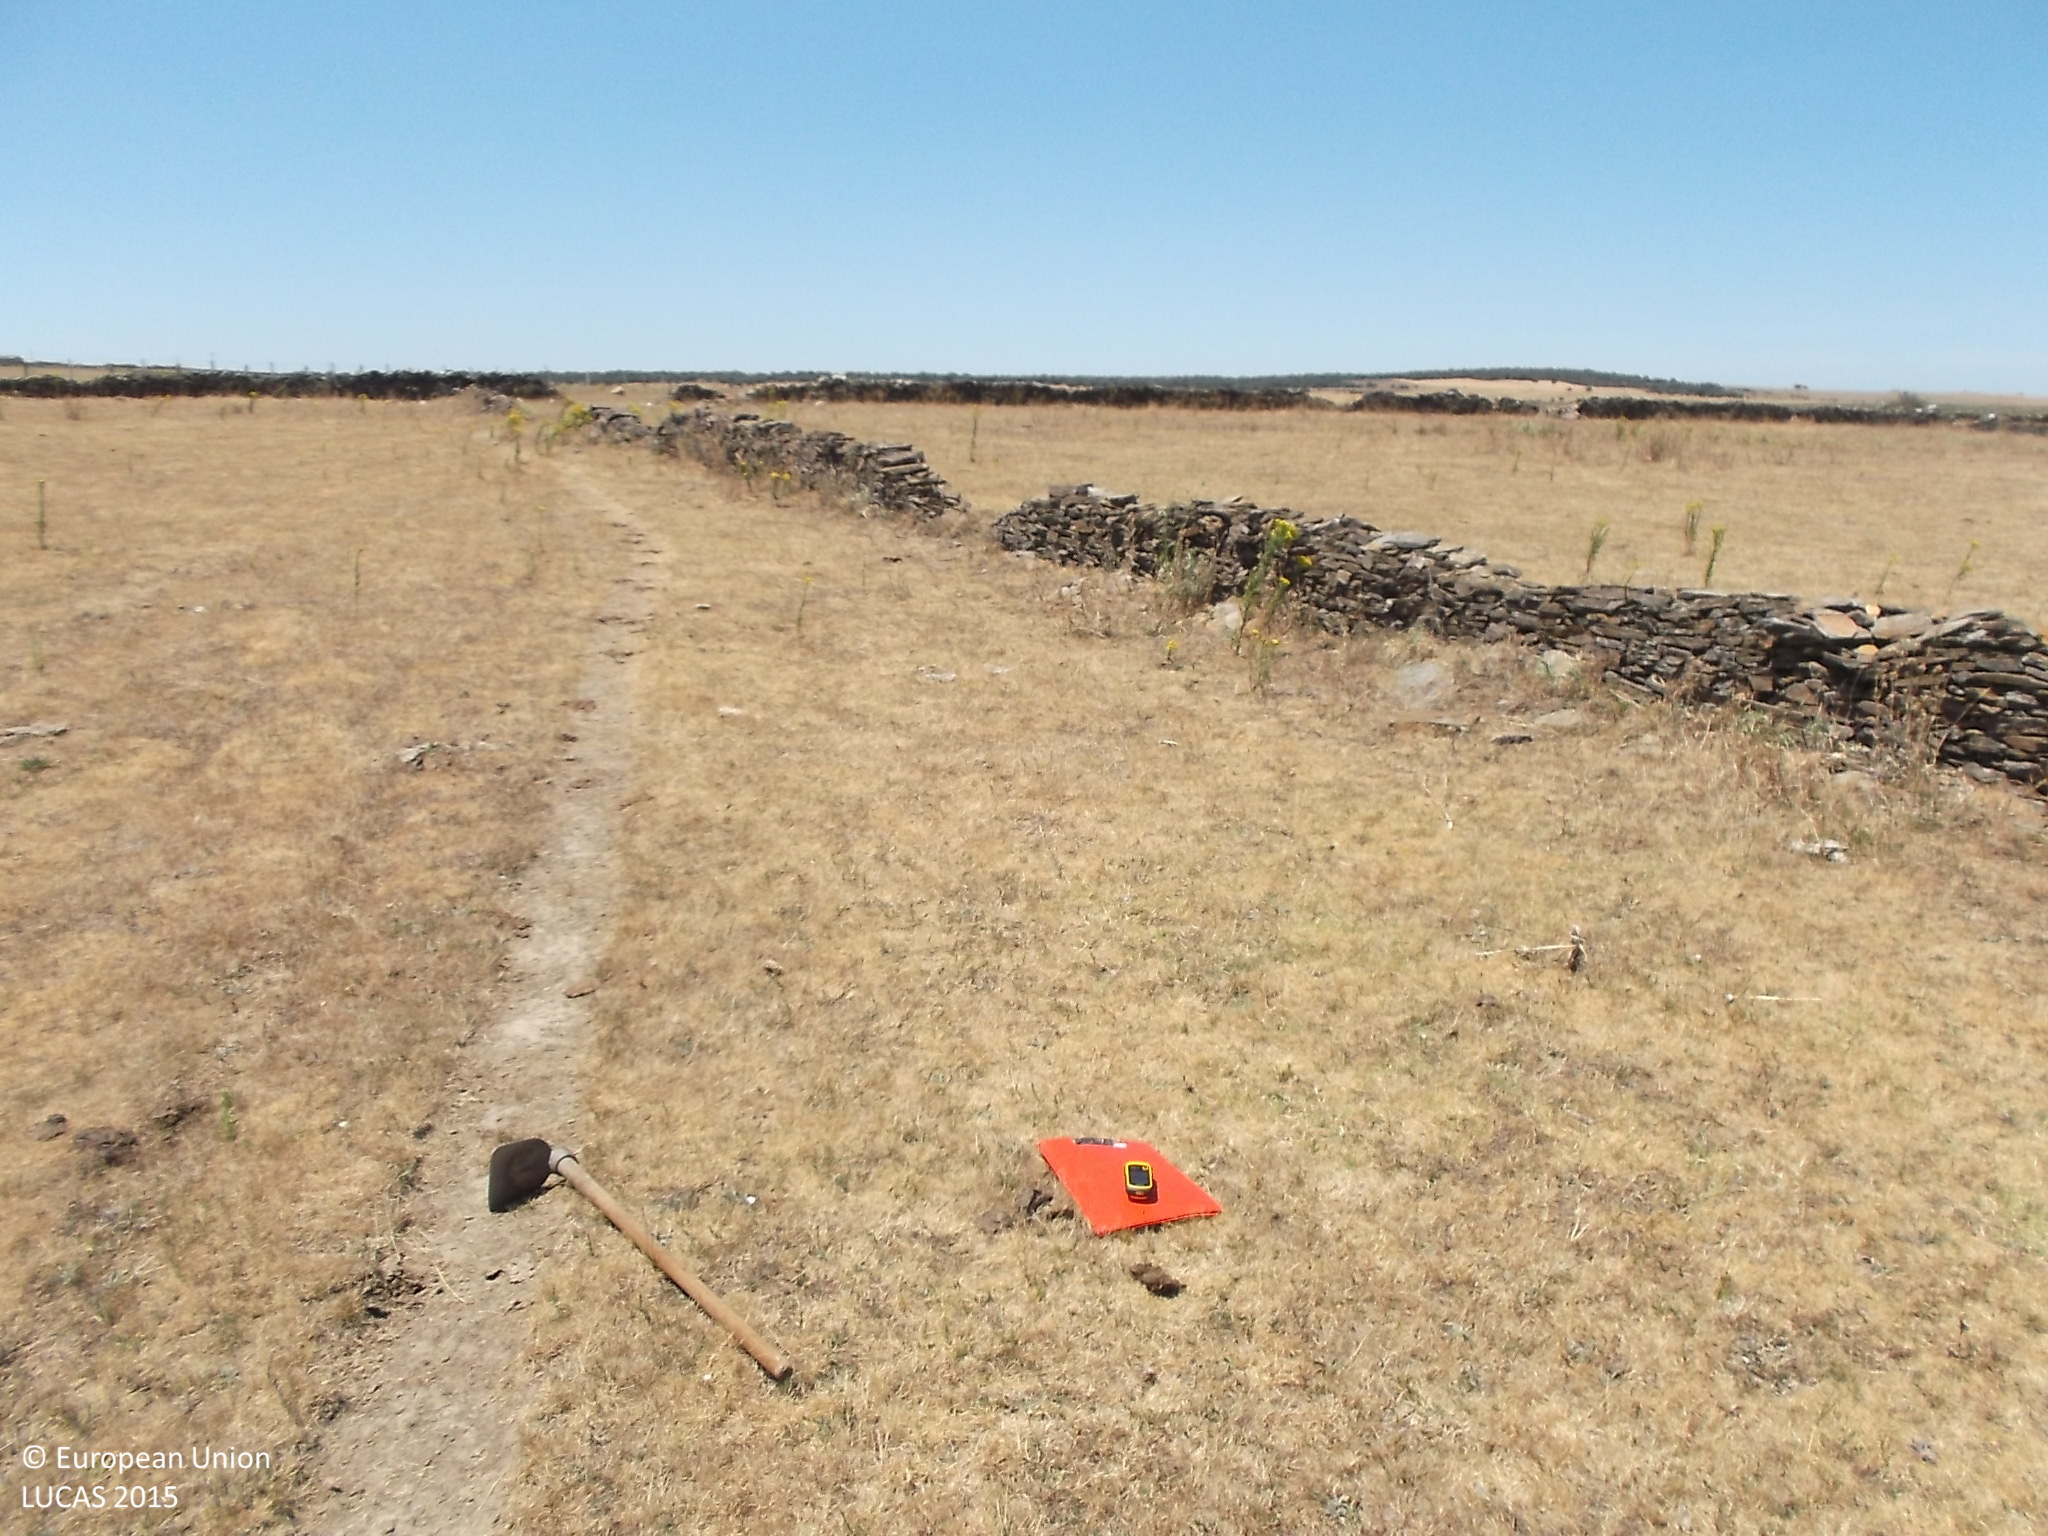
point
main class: Grassland
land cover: Grassland without tree/shrub cover
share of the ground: > 75 %
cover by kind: herbaceous plants 100 %
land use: Agriculture (excluding fallow land and kitchen gardens)
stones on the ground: < 10 %
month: July
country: ES
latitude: 40.7172
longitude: -6.7285
